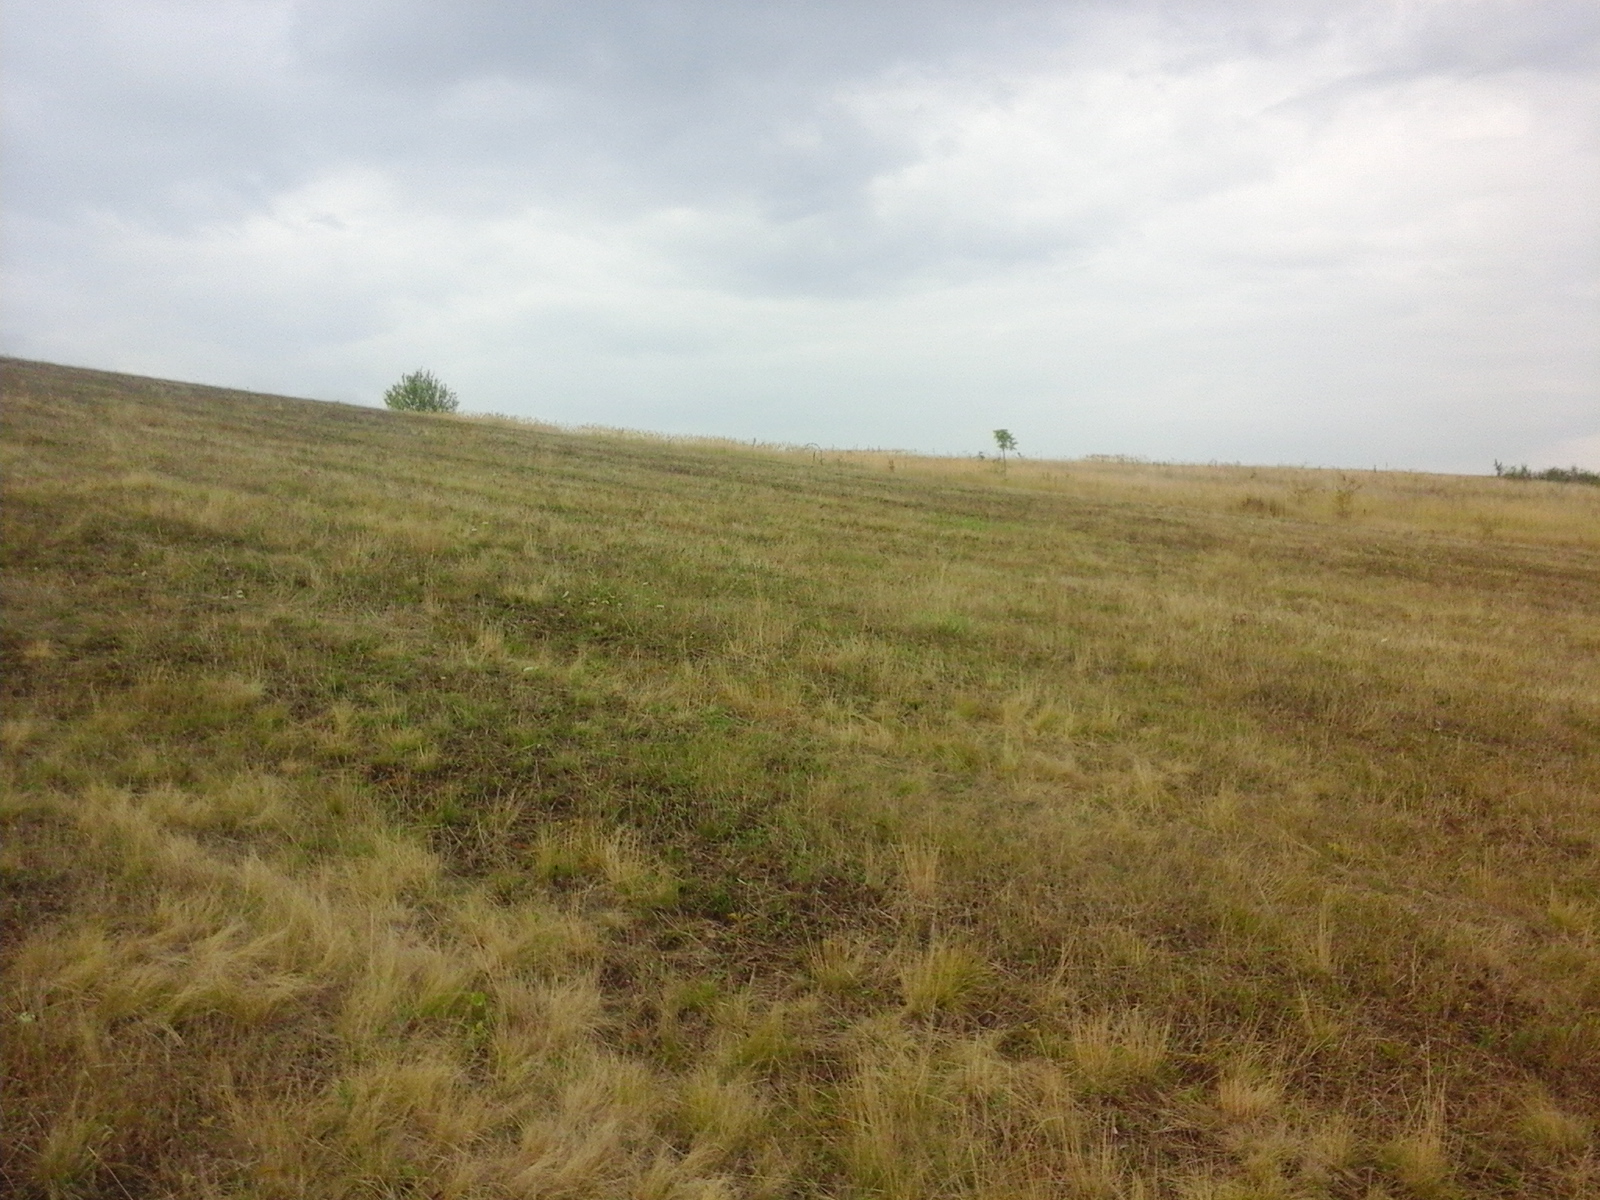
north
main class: Grassland
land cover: Grassland without tree/shrub cover
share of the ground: > 75 %
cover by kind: herbaceous plants 100 %
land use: Agriculture (excluding fallow land and kitchen gardens)
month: August
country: RO
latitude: 45.5511
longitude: 21.6264
